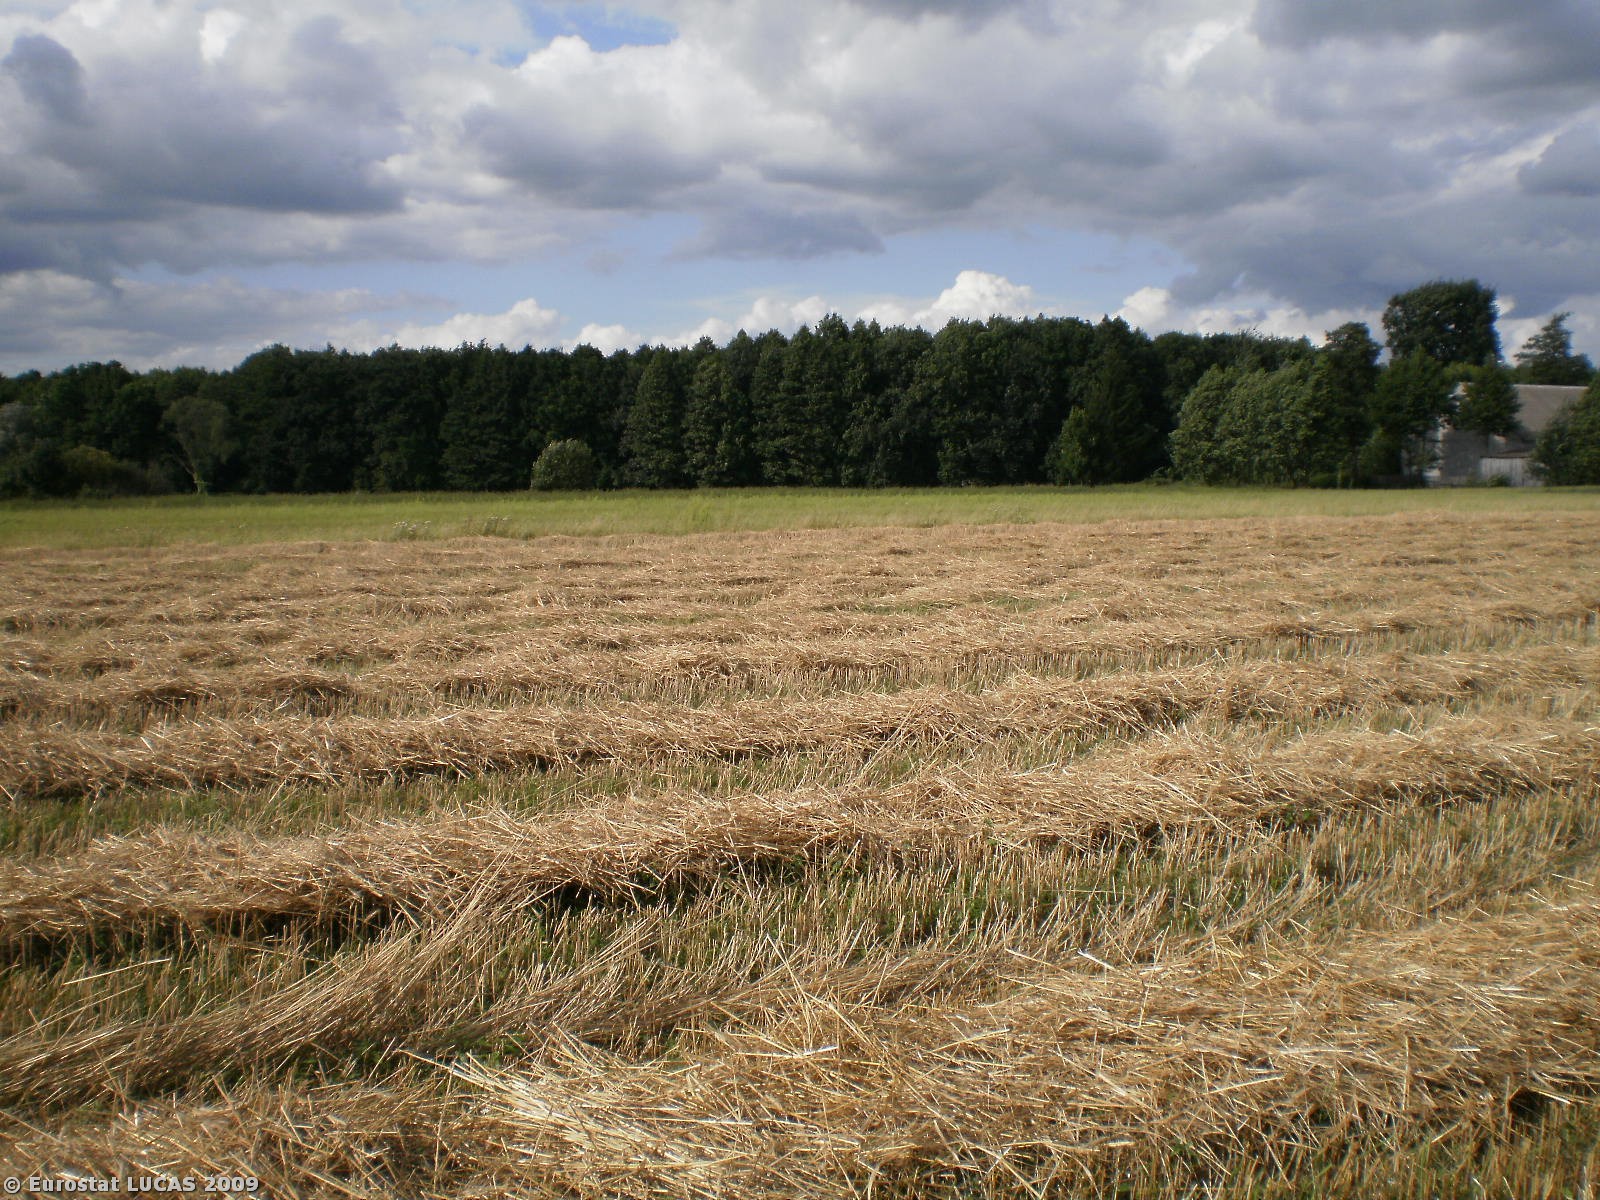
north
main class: Cropland
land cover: Rye
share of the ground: < 10 %
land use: Agriculture (excluding fallow land and kitchen gardens)
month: August
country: PL
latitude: 53.0916
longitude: 21.8369
